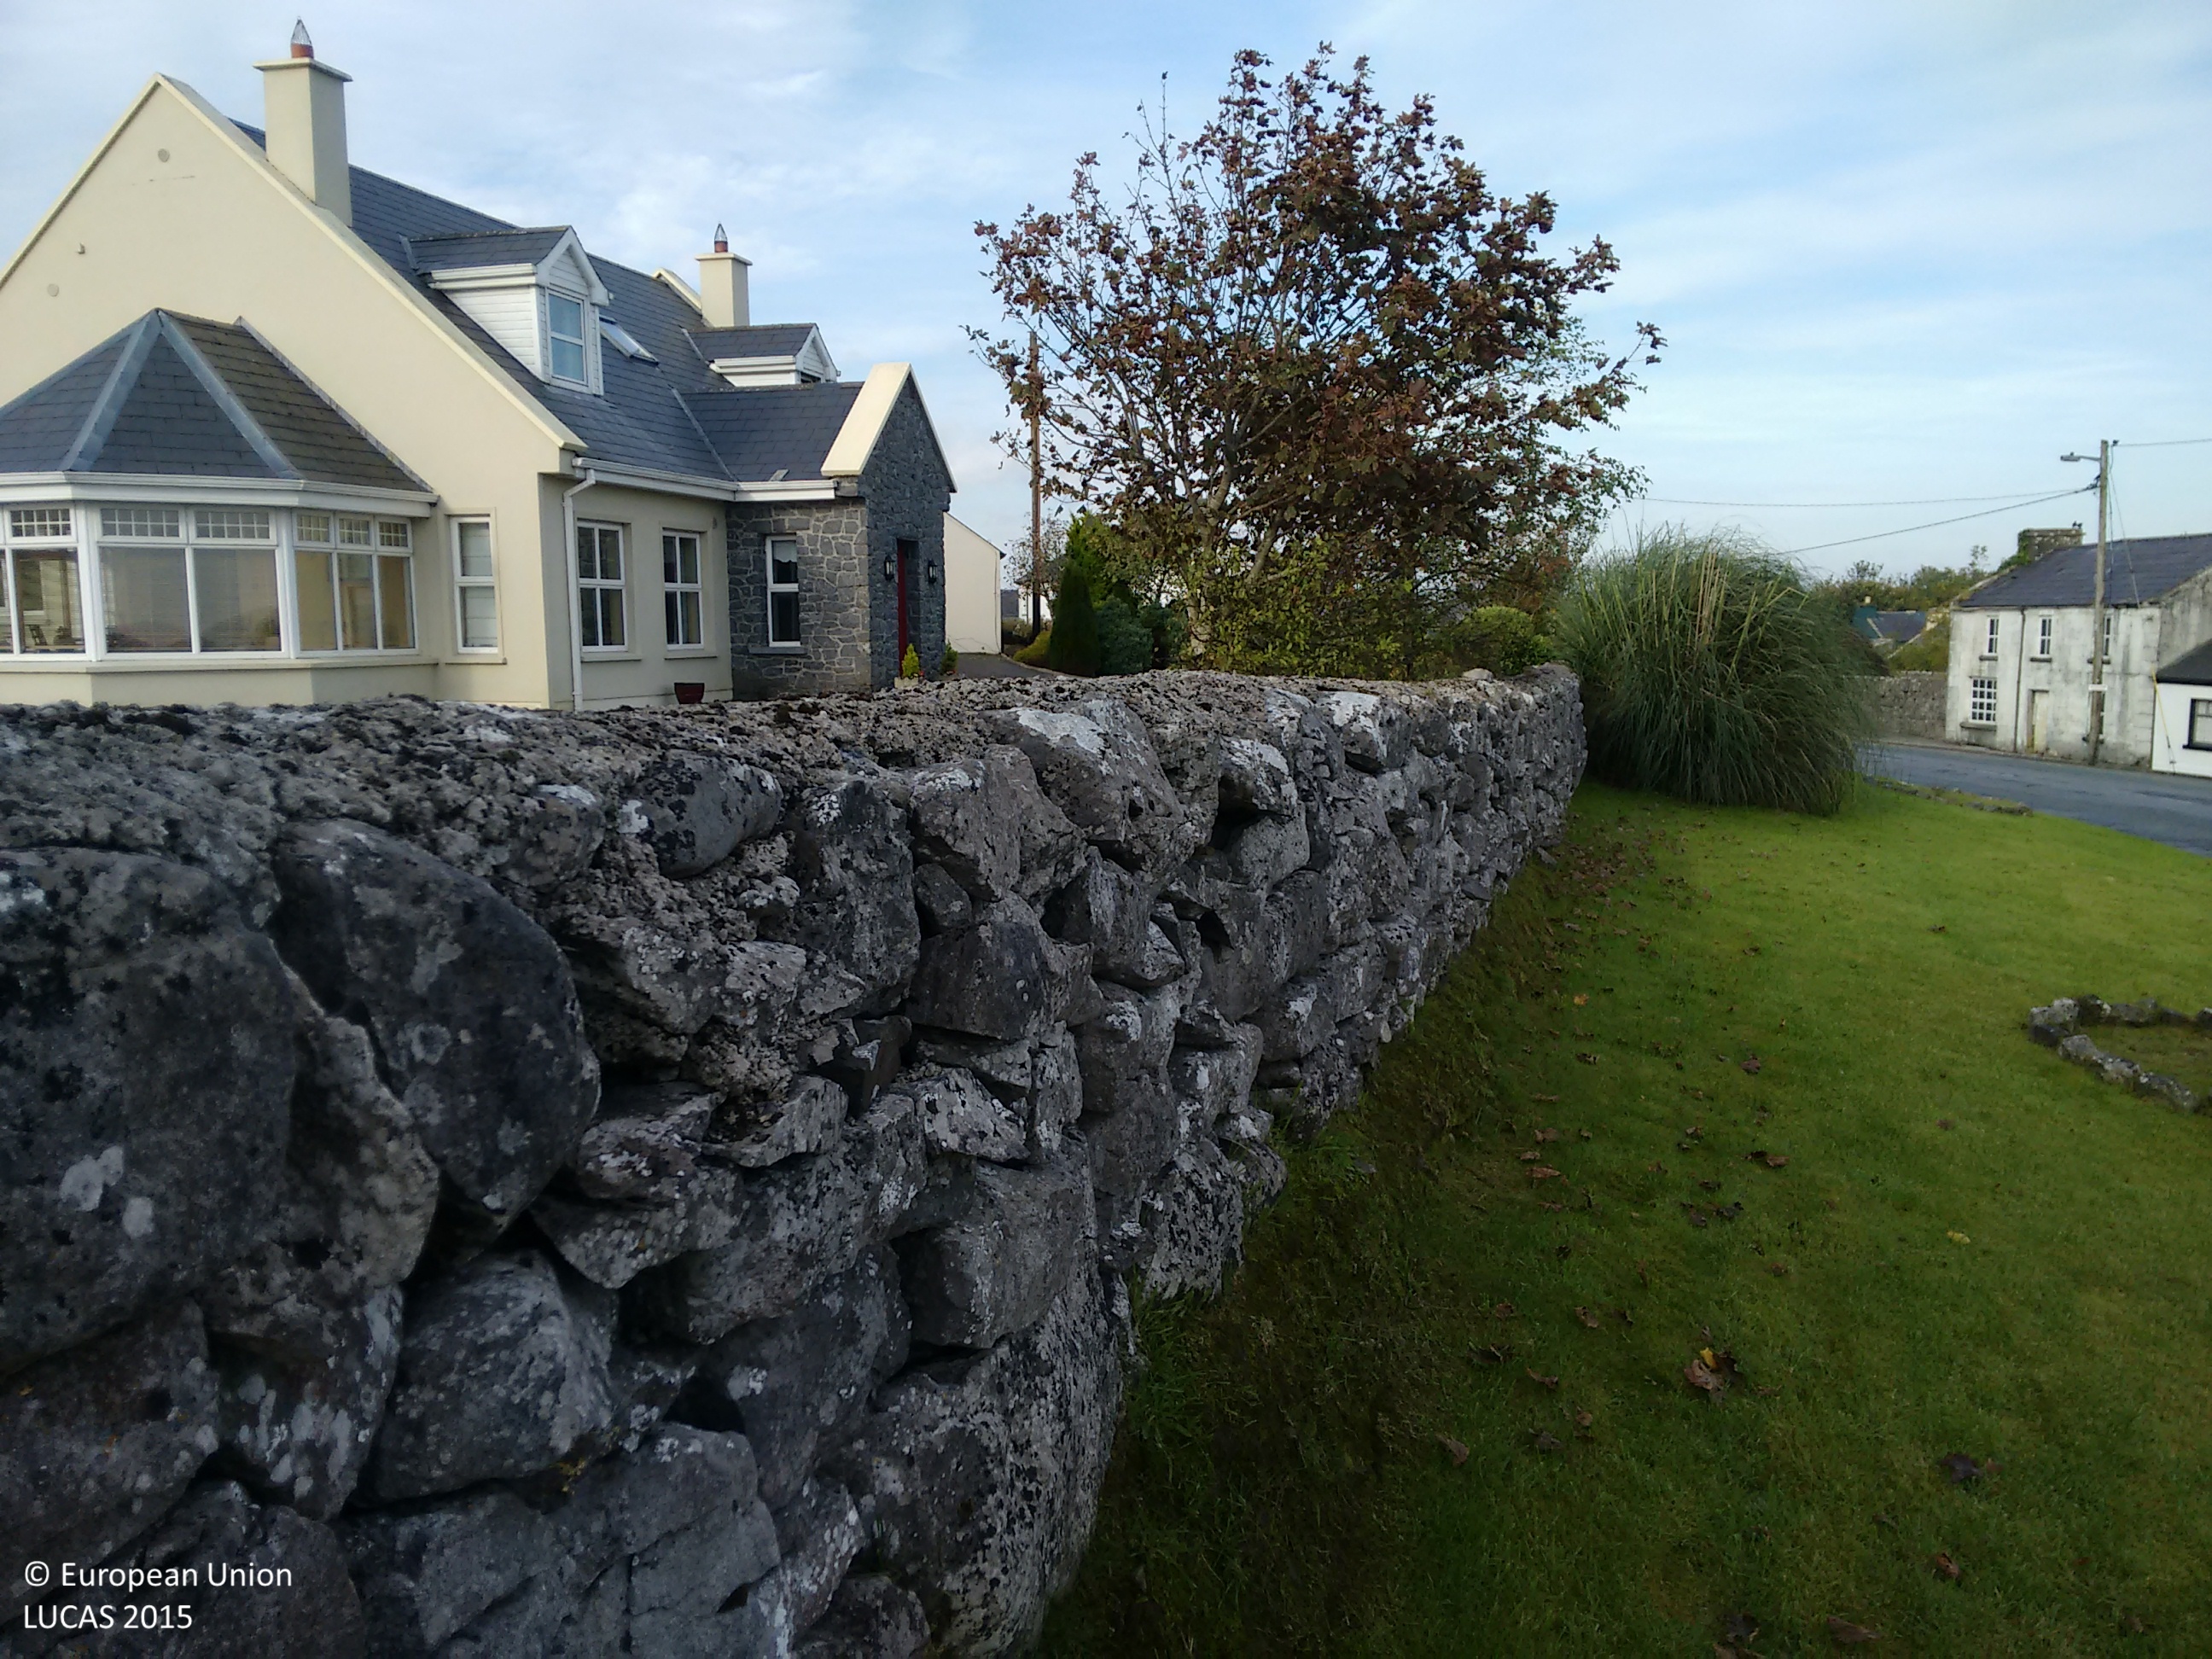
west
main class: Grassland
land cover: Grassland without tree/shrub cover
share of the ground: > 75 %
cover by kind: herbaceous plants 100 %
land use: Agriculture (excluding fallow land and kitchen gardens)
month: September
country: IE
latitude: 52.9890
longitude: -9.2148
